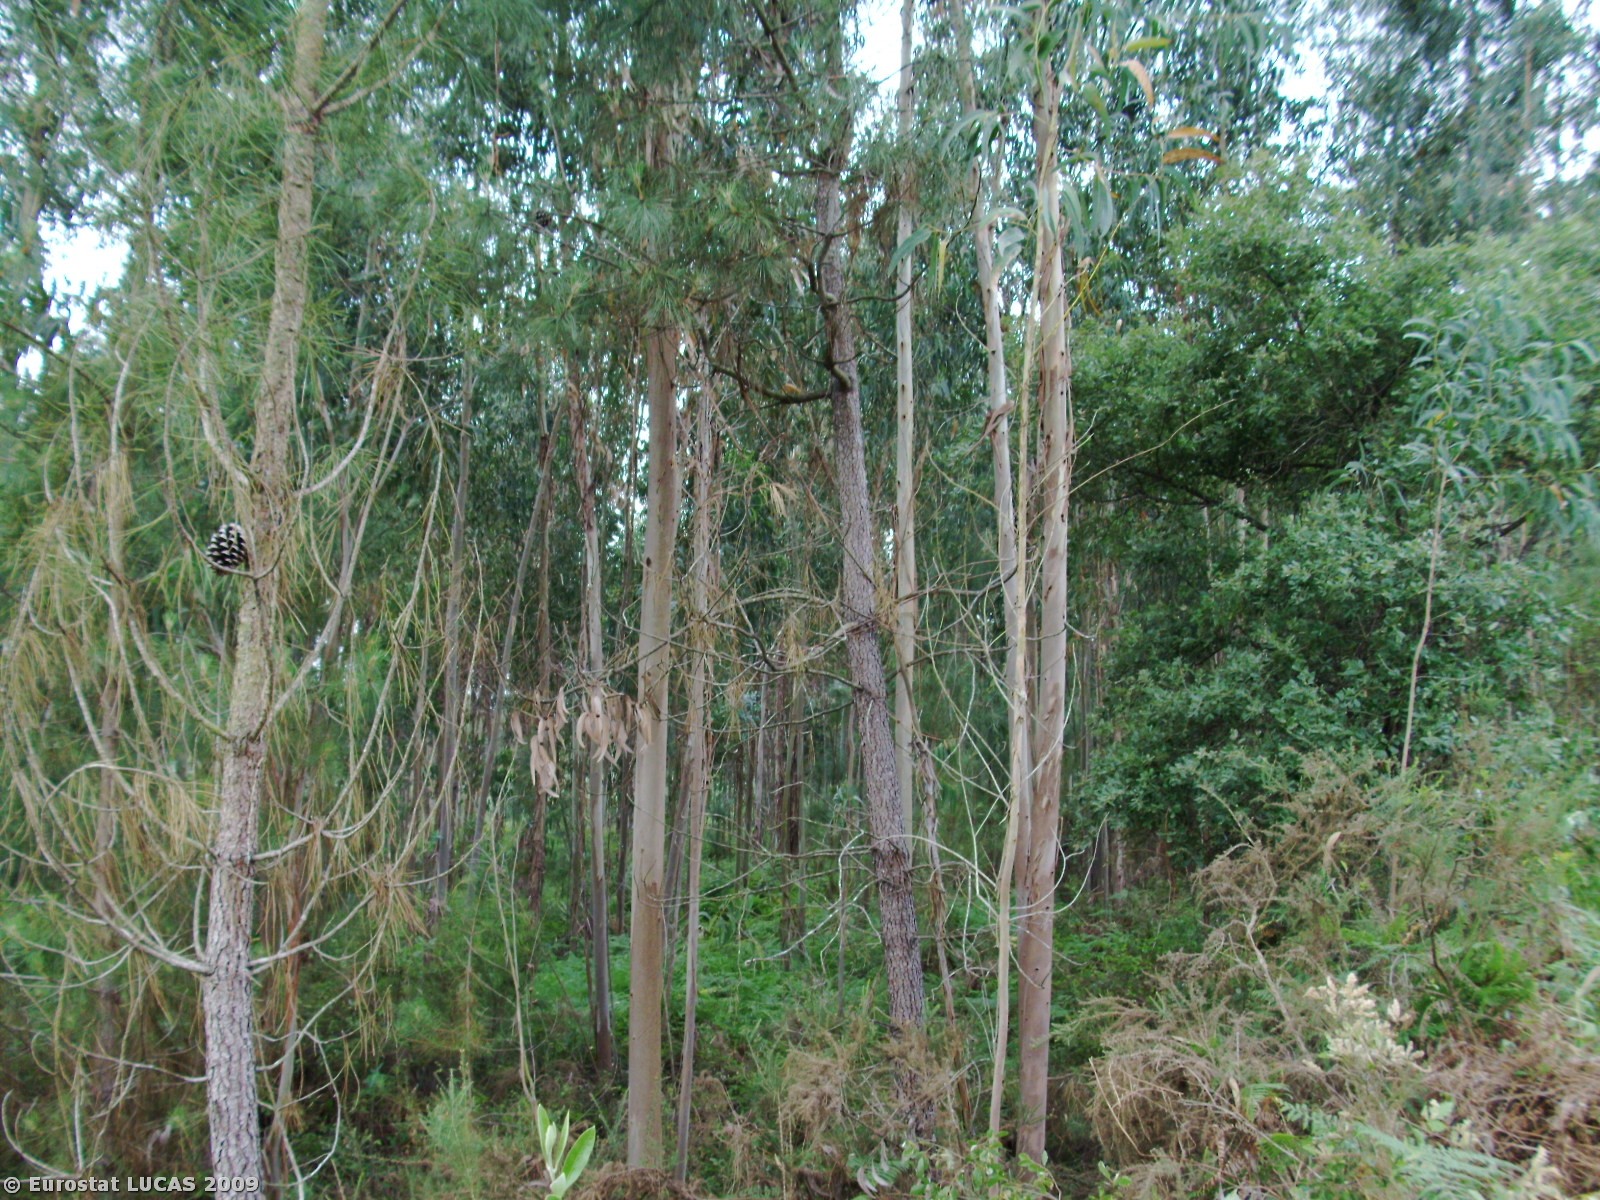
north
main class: Woodland
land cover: Broadleaved woodland
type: plantations and self-sown exotic forest
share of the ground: 10 - 25 %
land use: Forestry
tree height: > 5 m
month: June
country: PT
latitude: 39.7257
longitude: -8.3306
